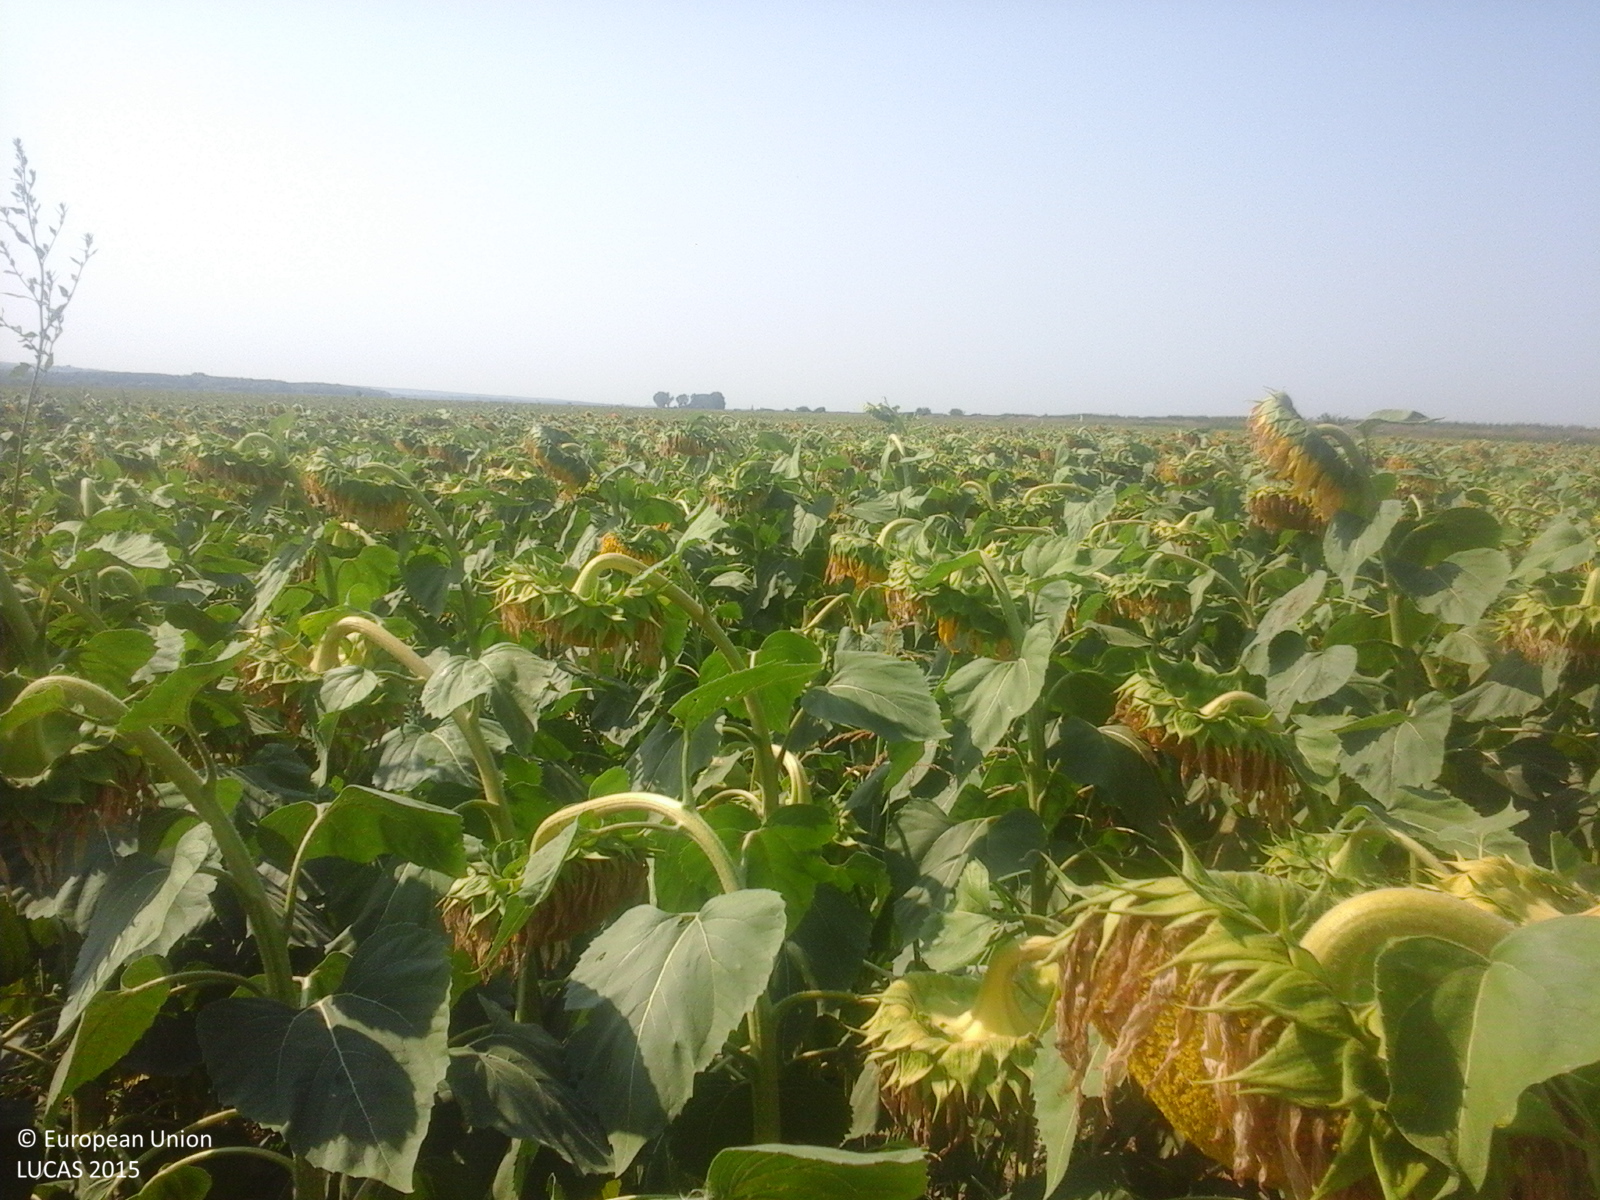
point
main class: Cropland
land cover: Sunflower
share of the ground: > 75 %
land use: Agriculture (excluding fallow land and kitchen gardens)
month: July
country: RO
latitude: 45.7220
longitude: 28.1506
